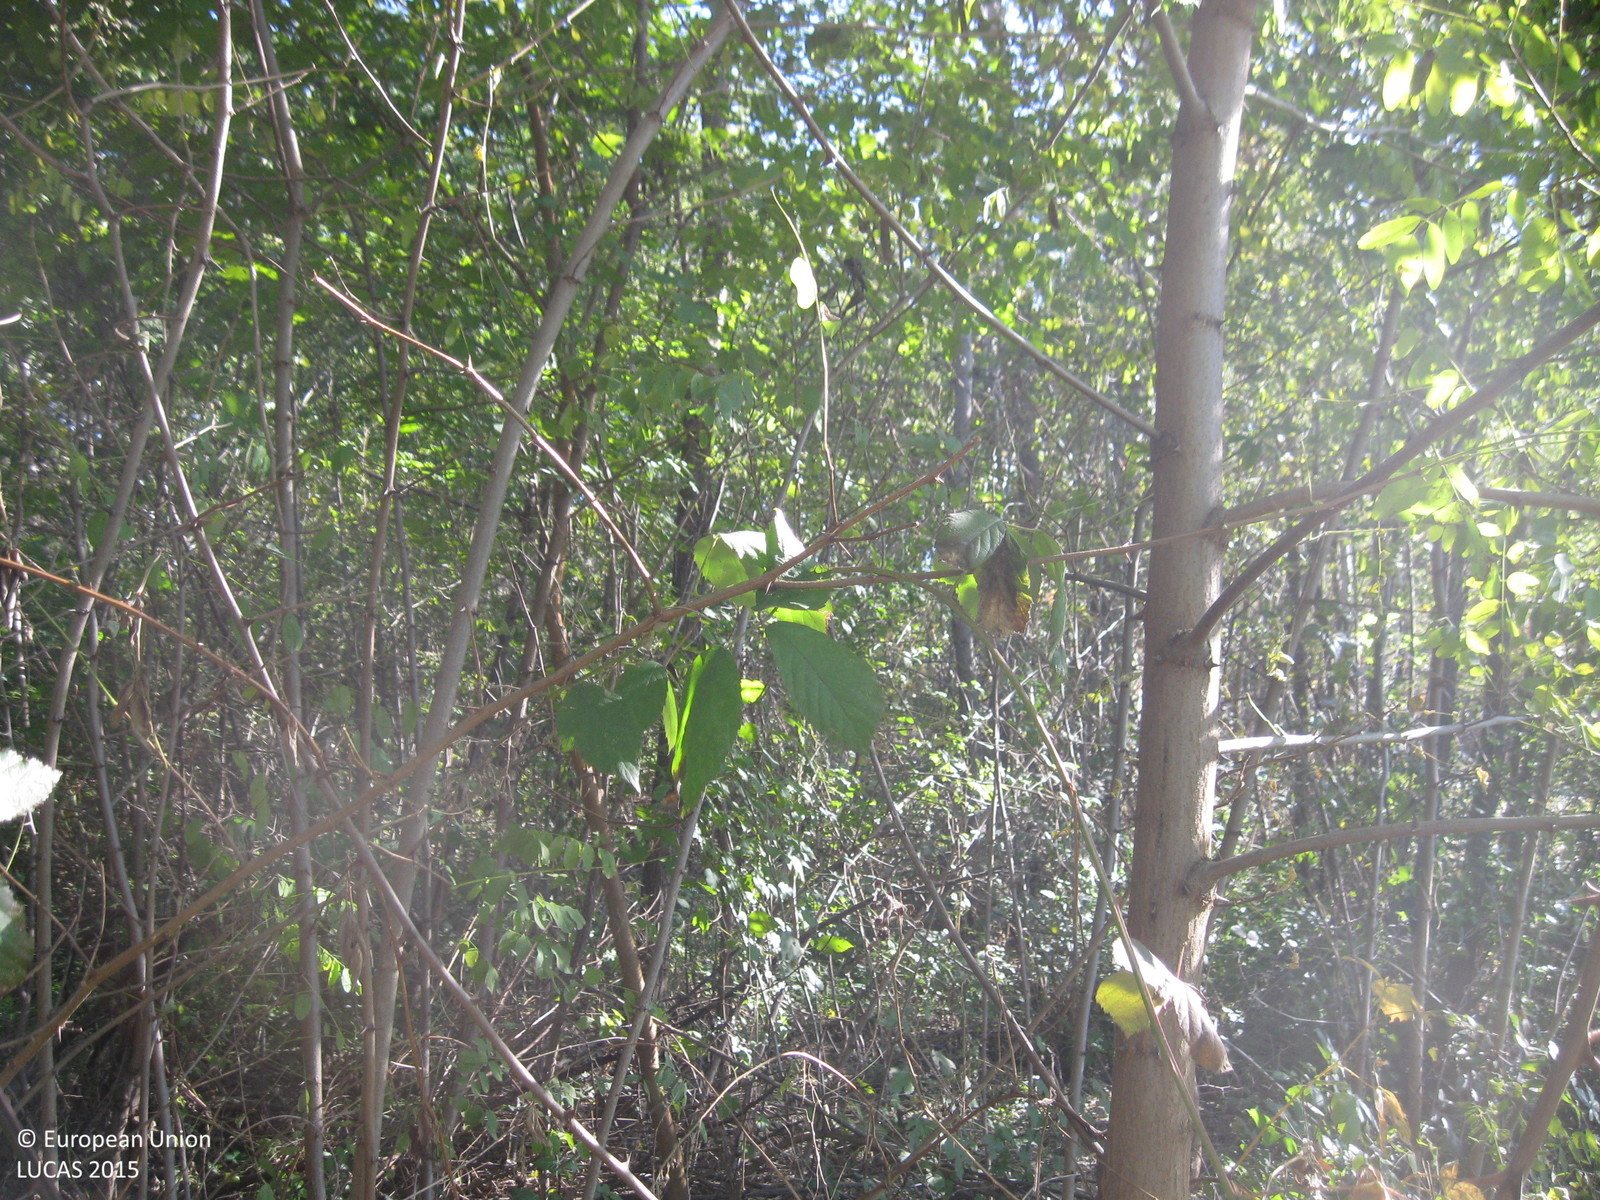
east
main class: Woodland
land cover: Broadleaved woodland
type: floodplain forest
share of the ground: > 75 %
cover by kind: broadleaved forest trees 90 %, shrubs 10 %
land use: Semi-natural and natural areas not in use
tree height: > 5 m
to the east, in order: Broadleaved woodland; Inland fresh running water; Broadleaved woodland; Permanent crops (only in case pi)
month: November
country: BG
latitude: 42.3835
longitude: 24.0465
